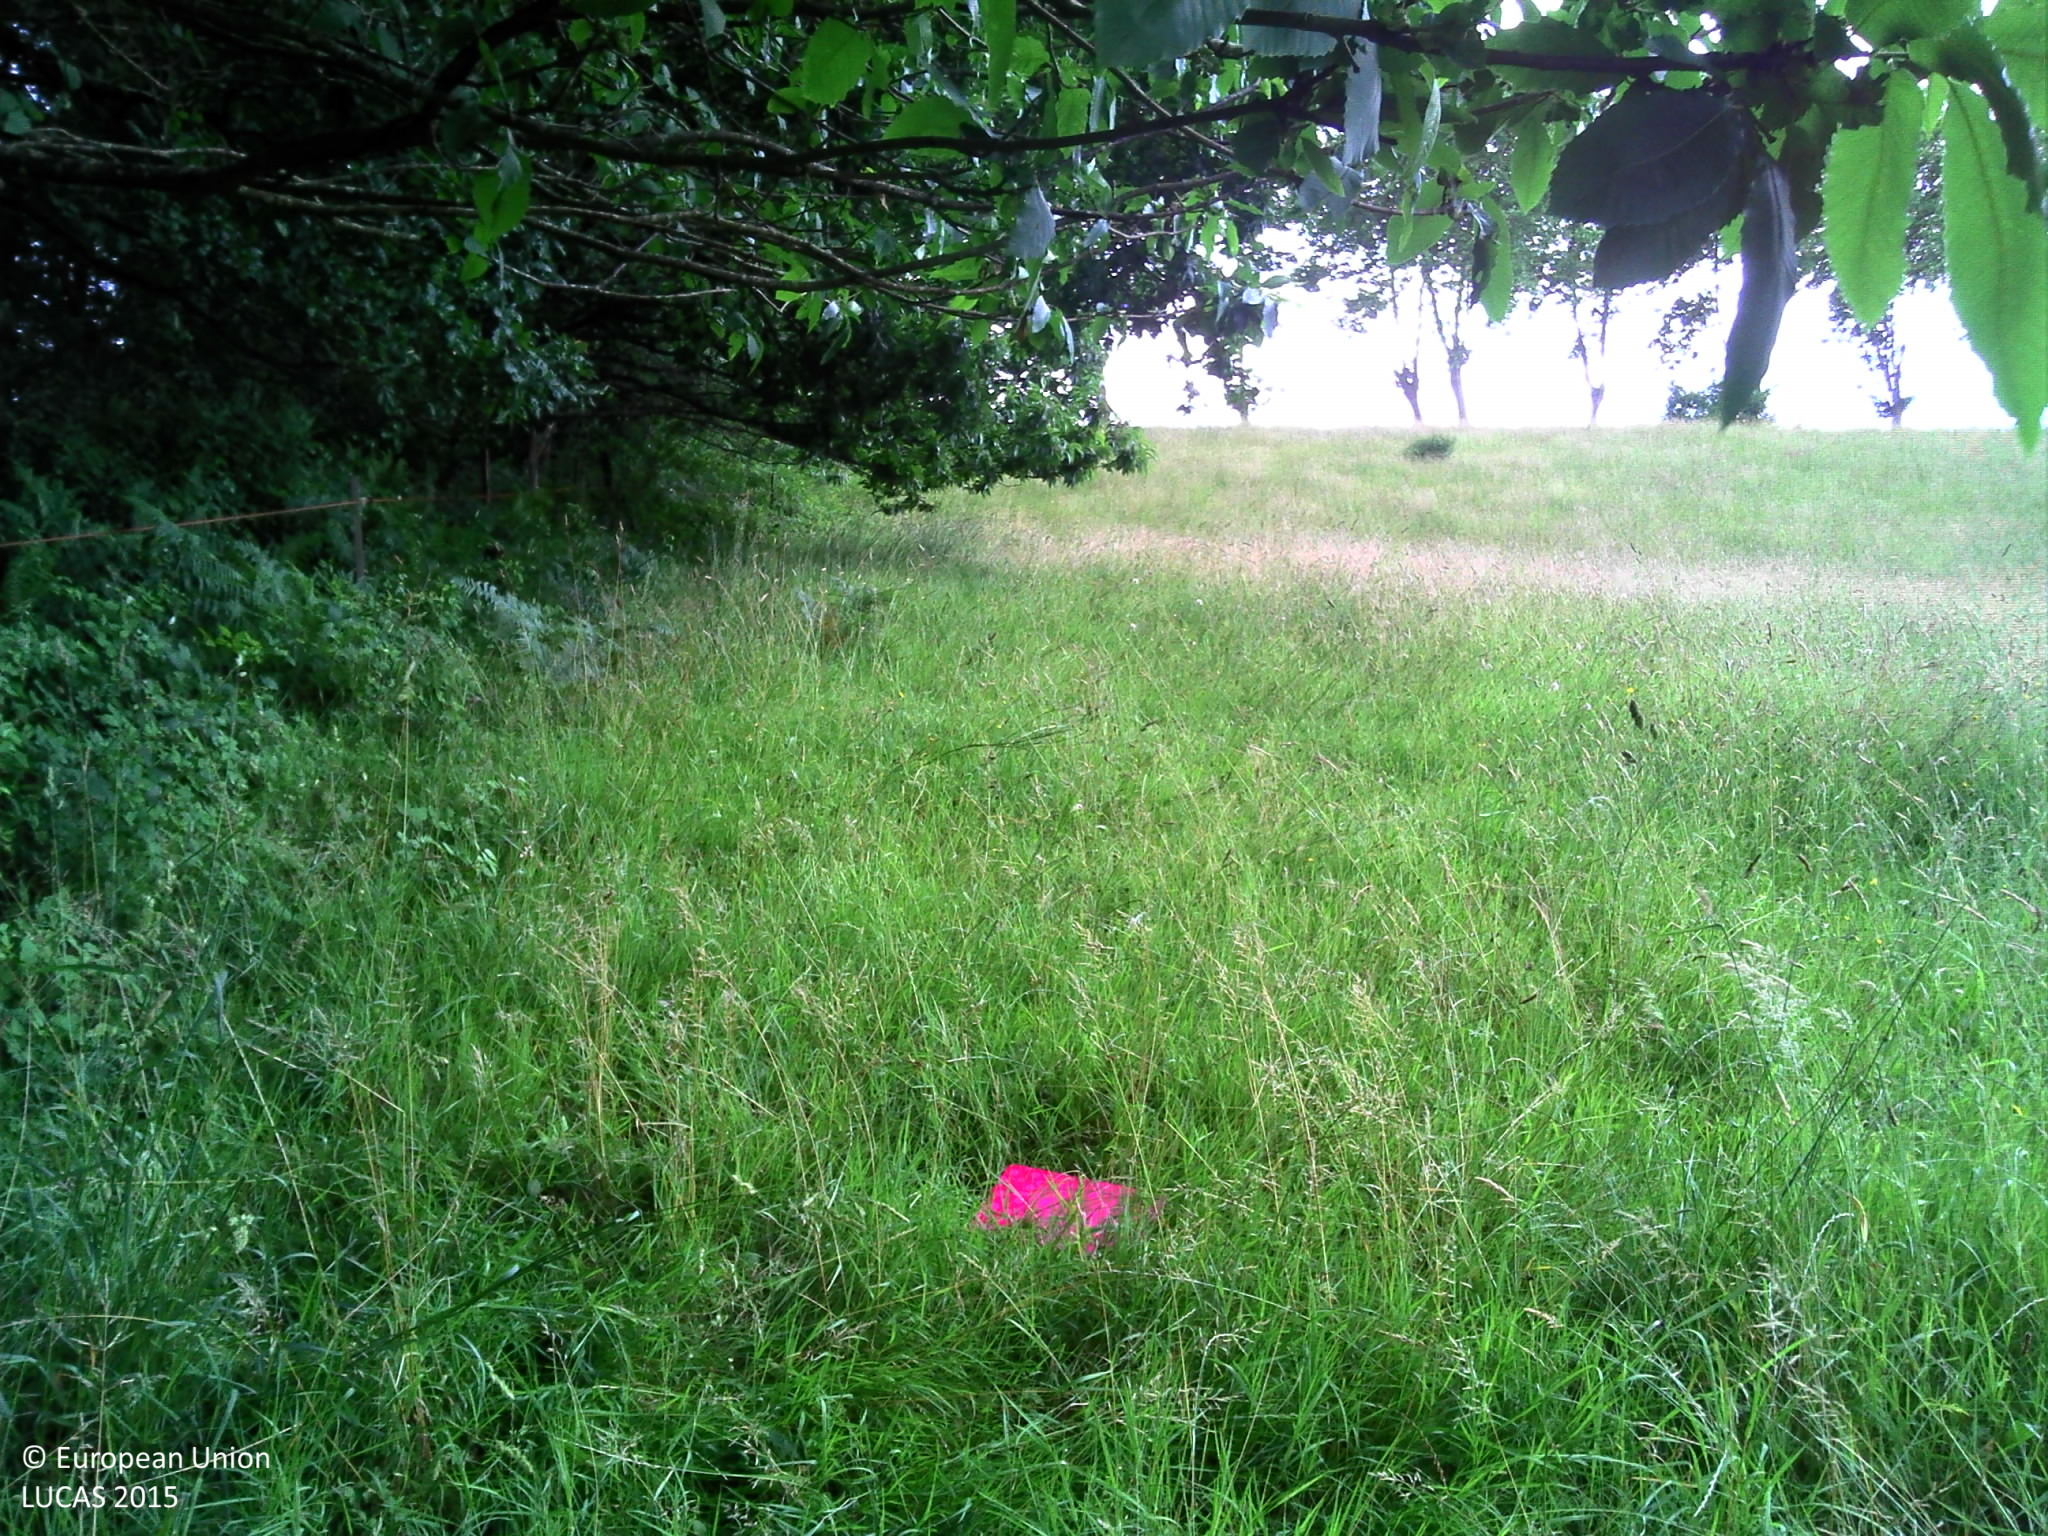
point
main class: Grassland
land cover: Grassland without tree/shrub cover
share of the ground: > 75 %
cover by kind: herbaceous plants 100 %
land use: Agriculture (excluding fallow land and kitchen gardens)
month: June
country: FR
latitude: 43.3024
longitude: -0.7222
